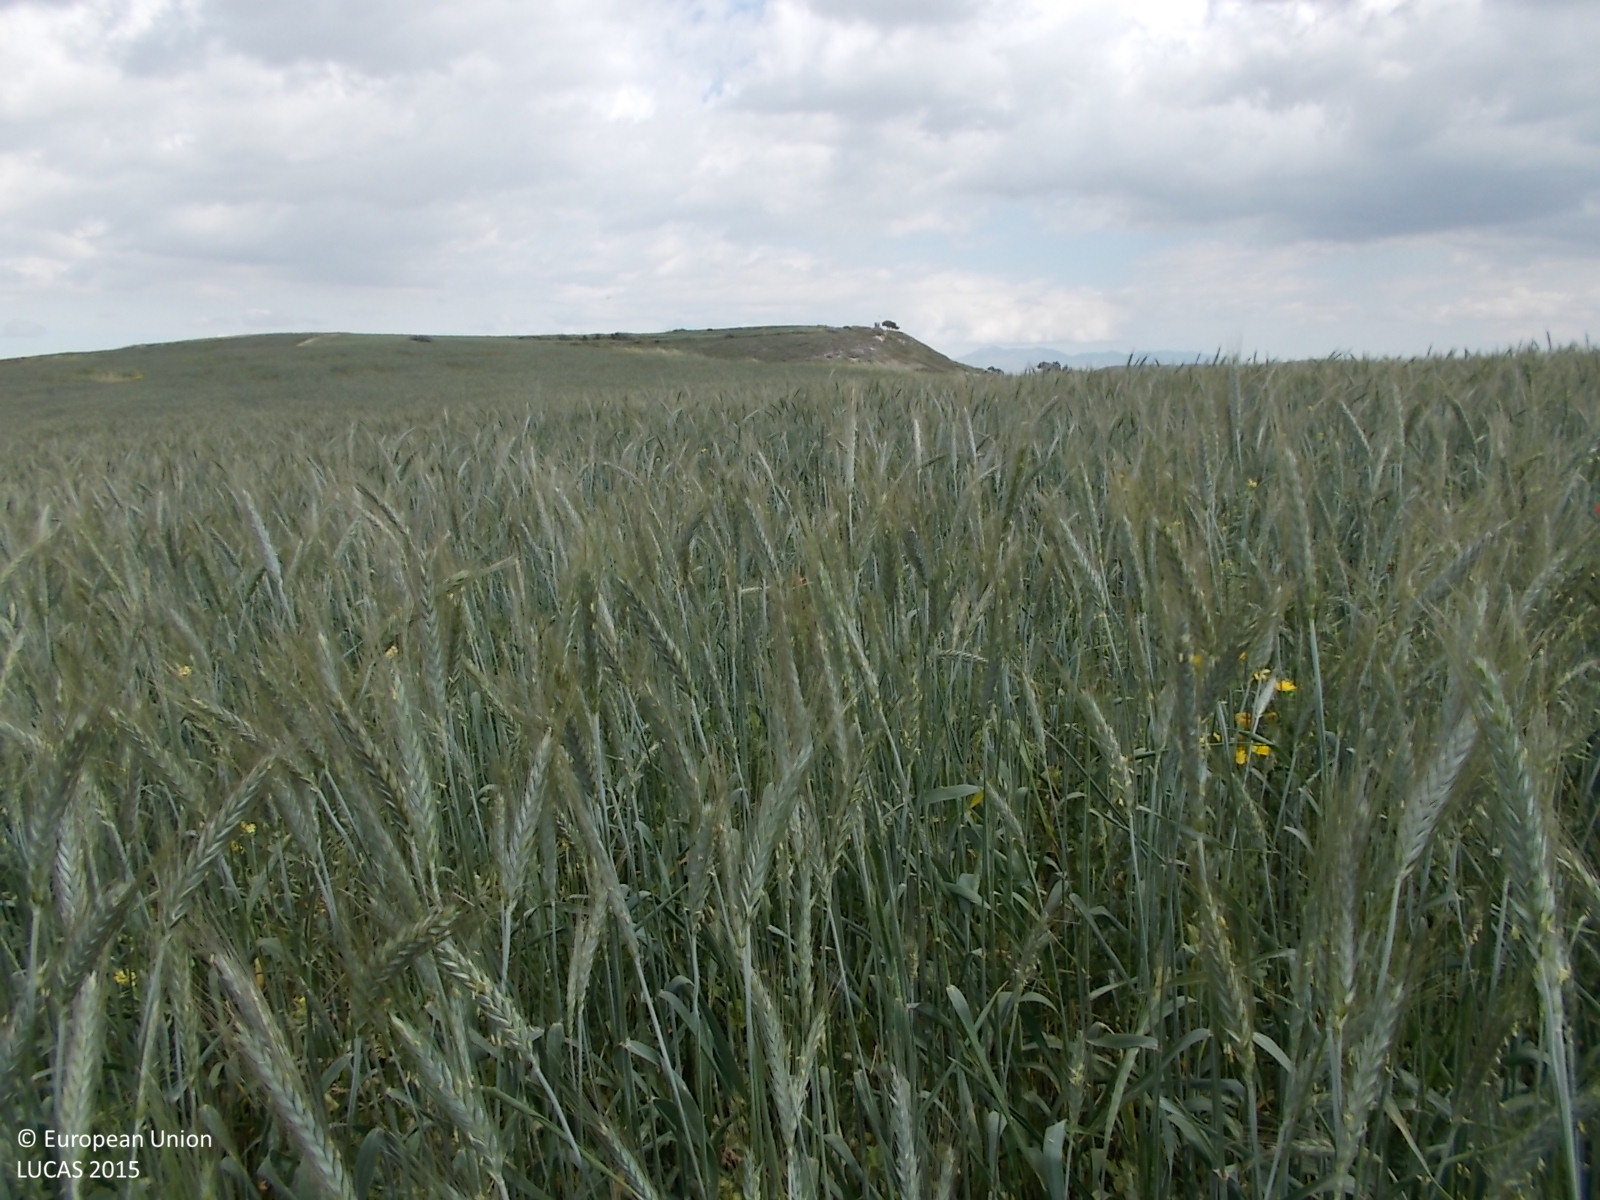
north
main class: Cropland
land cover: Mixed cereals for fodder
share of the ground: > 75 %
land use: Agriculture (excluding fallow land and kitchen gardens)
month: April
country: CY
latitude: 35.0427
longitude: 33.4902
